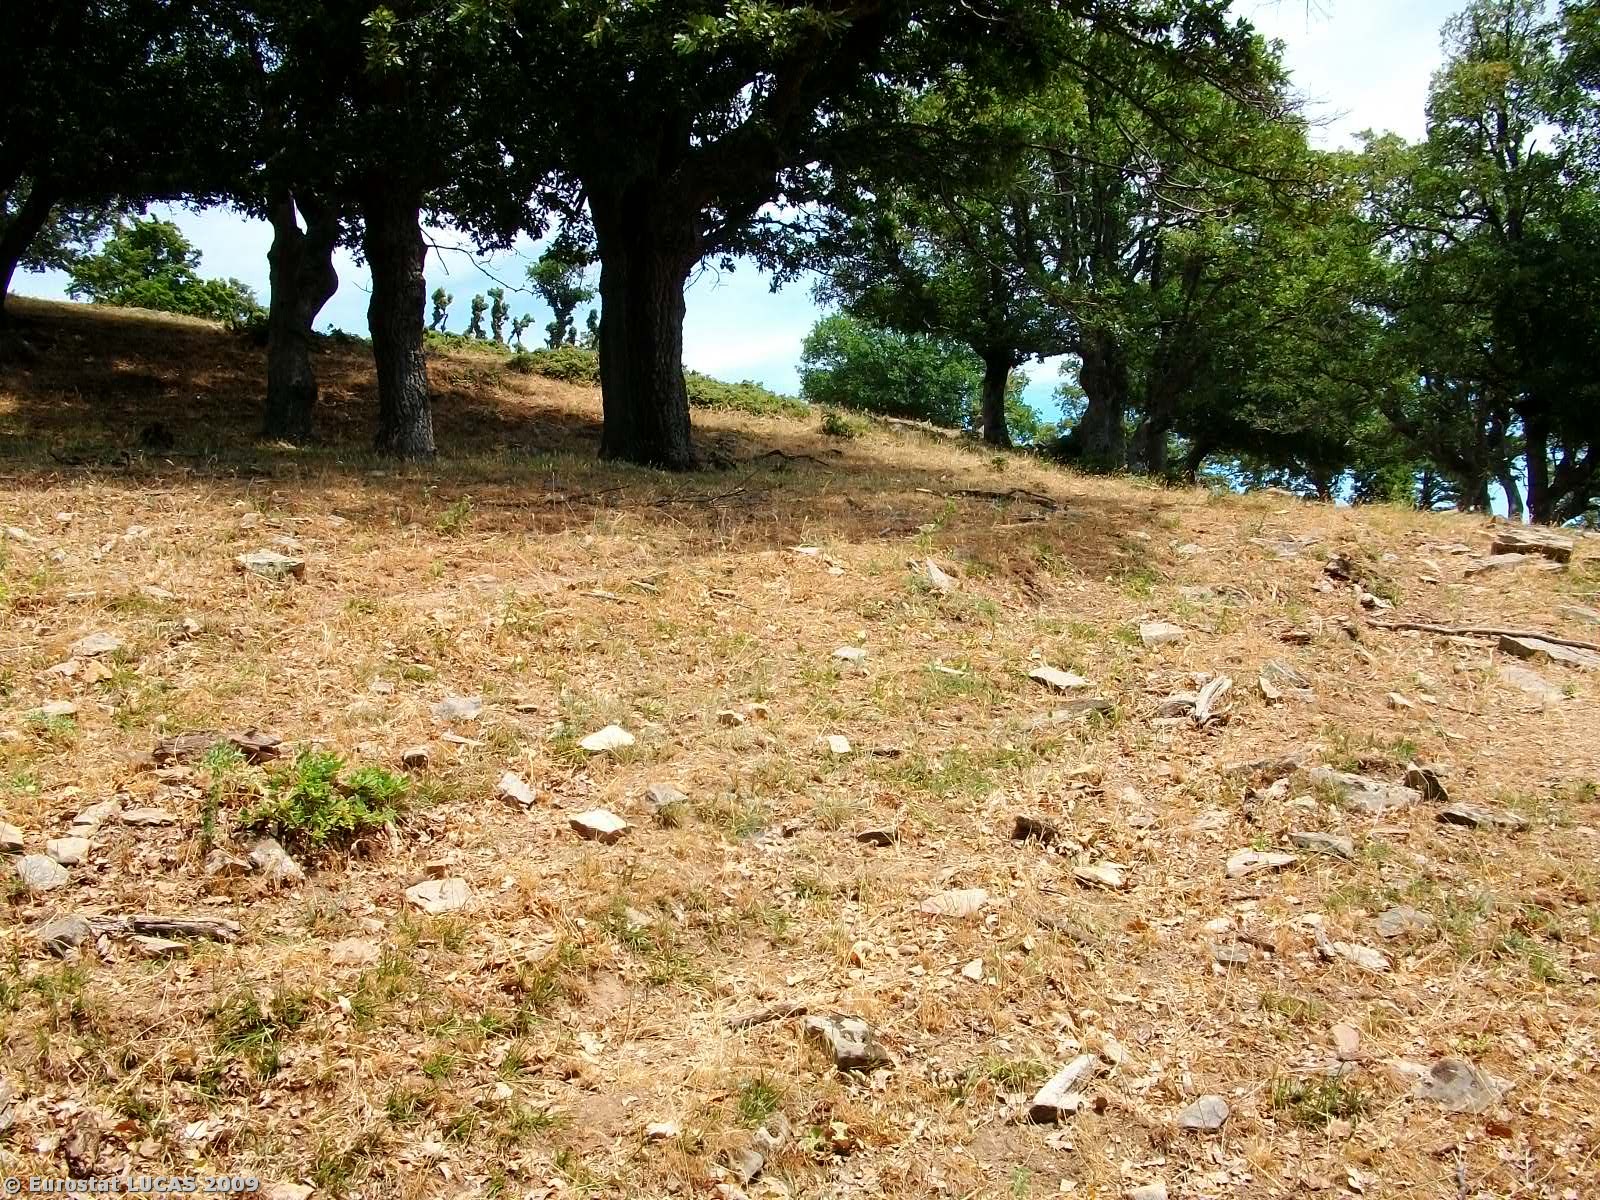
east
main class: Woodland
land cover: Broadleaved woodland
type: thermophilous deciduous forest
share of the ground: 25 - 50 %
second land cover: Grassland with sparse tree/shrub cover
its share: > 75 %
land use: Agriculture (excluding fallow land and kitchen gardens)
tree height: > 5 m
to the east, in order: Broadleaved woodland; Grassland with sparse tree/shrub cover; Grassland without tree/shrub cover; Grassland with sparse tree/shrub cover
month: June
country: GR
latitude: 41.1226
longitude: 25.8407
